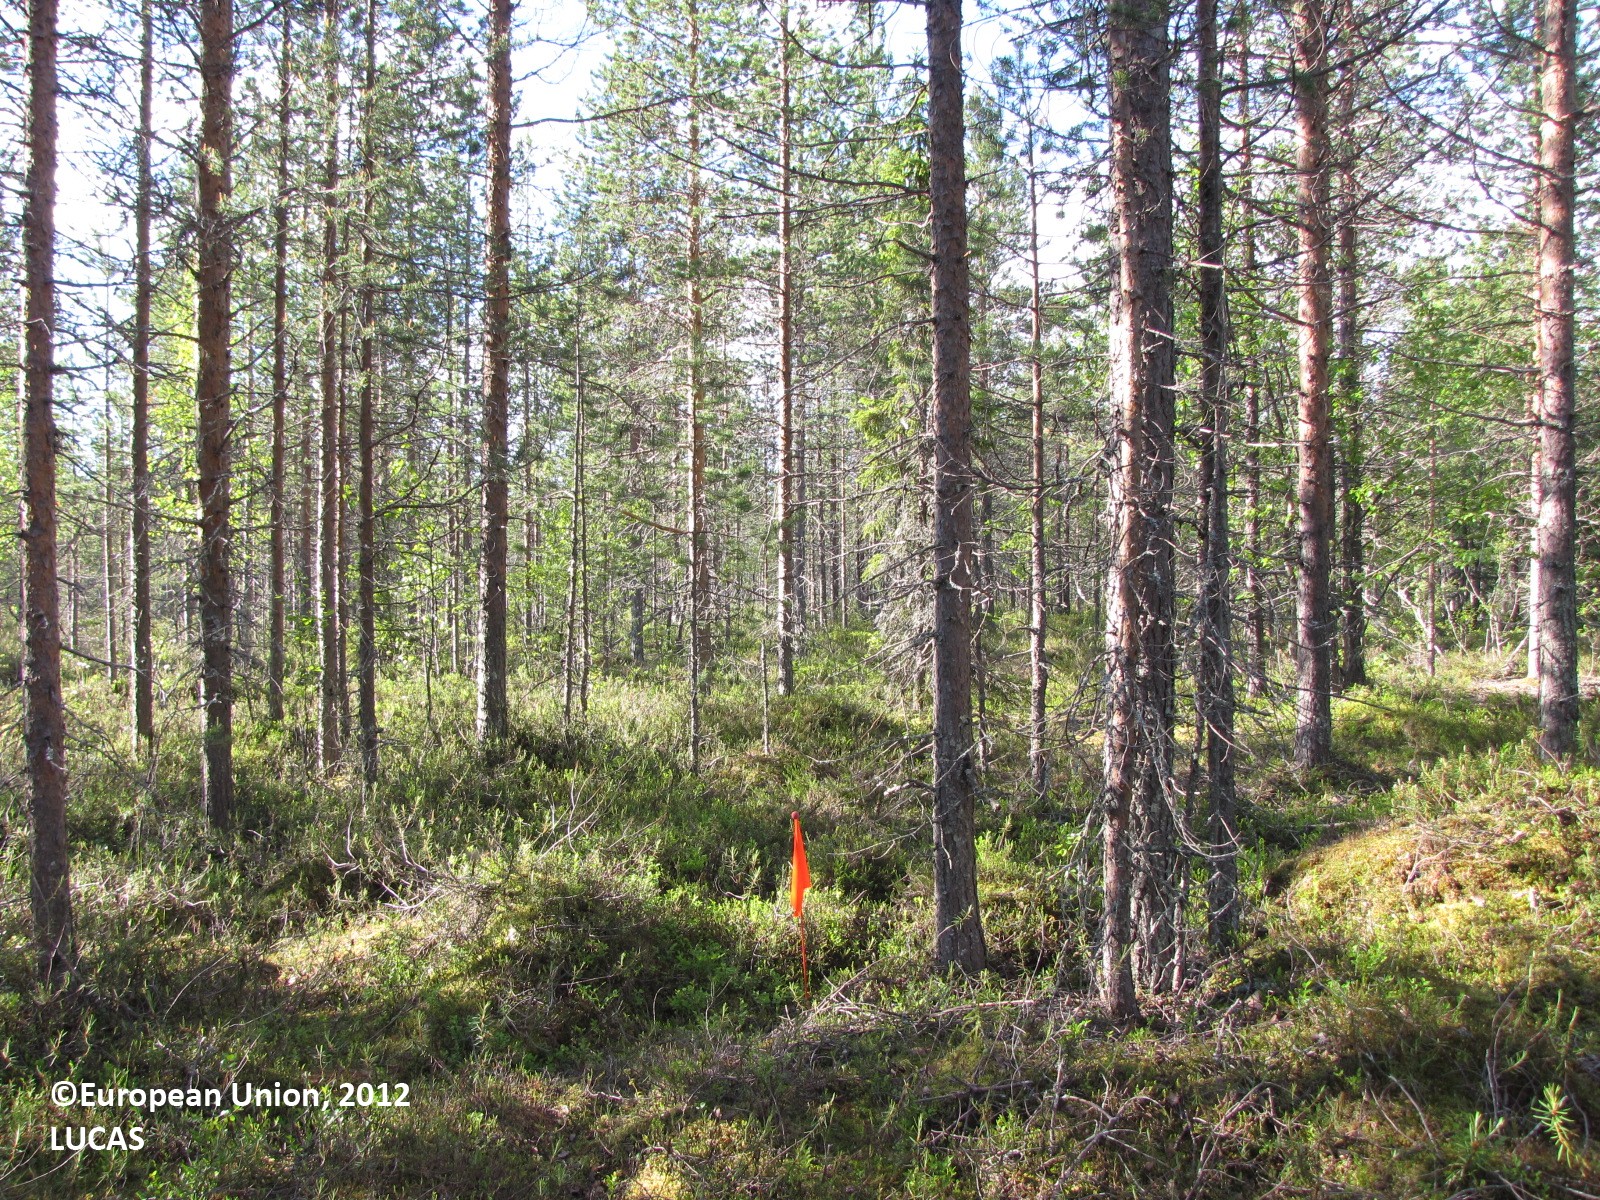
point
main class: Woodland
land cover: Pine dominated coniferous woodland
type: boreal forest
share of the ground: 50 - 75 %
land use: Forestry
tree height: > 5 m
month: June
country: FI
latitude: 66.2496
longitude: 24.3527
